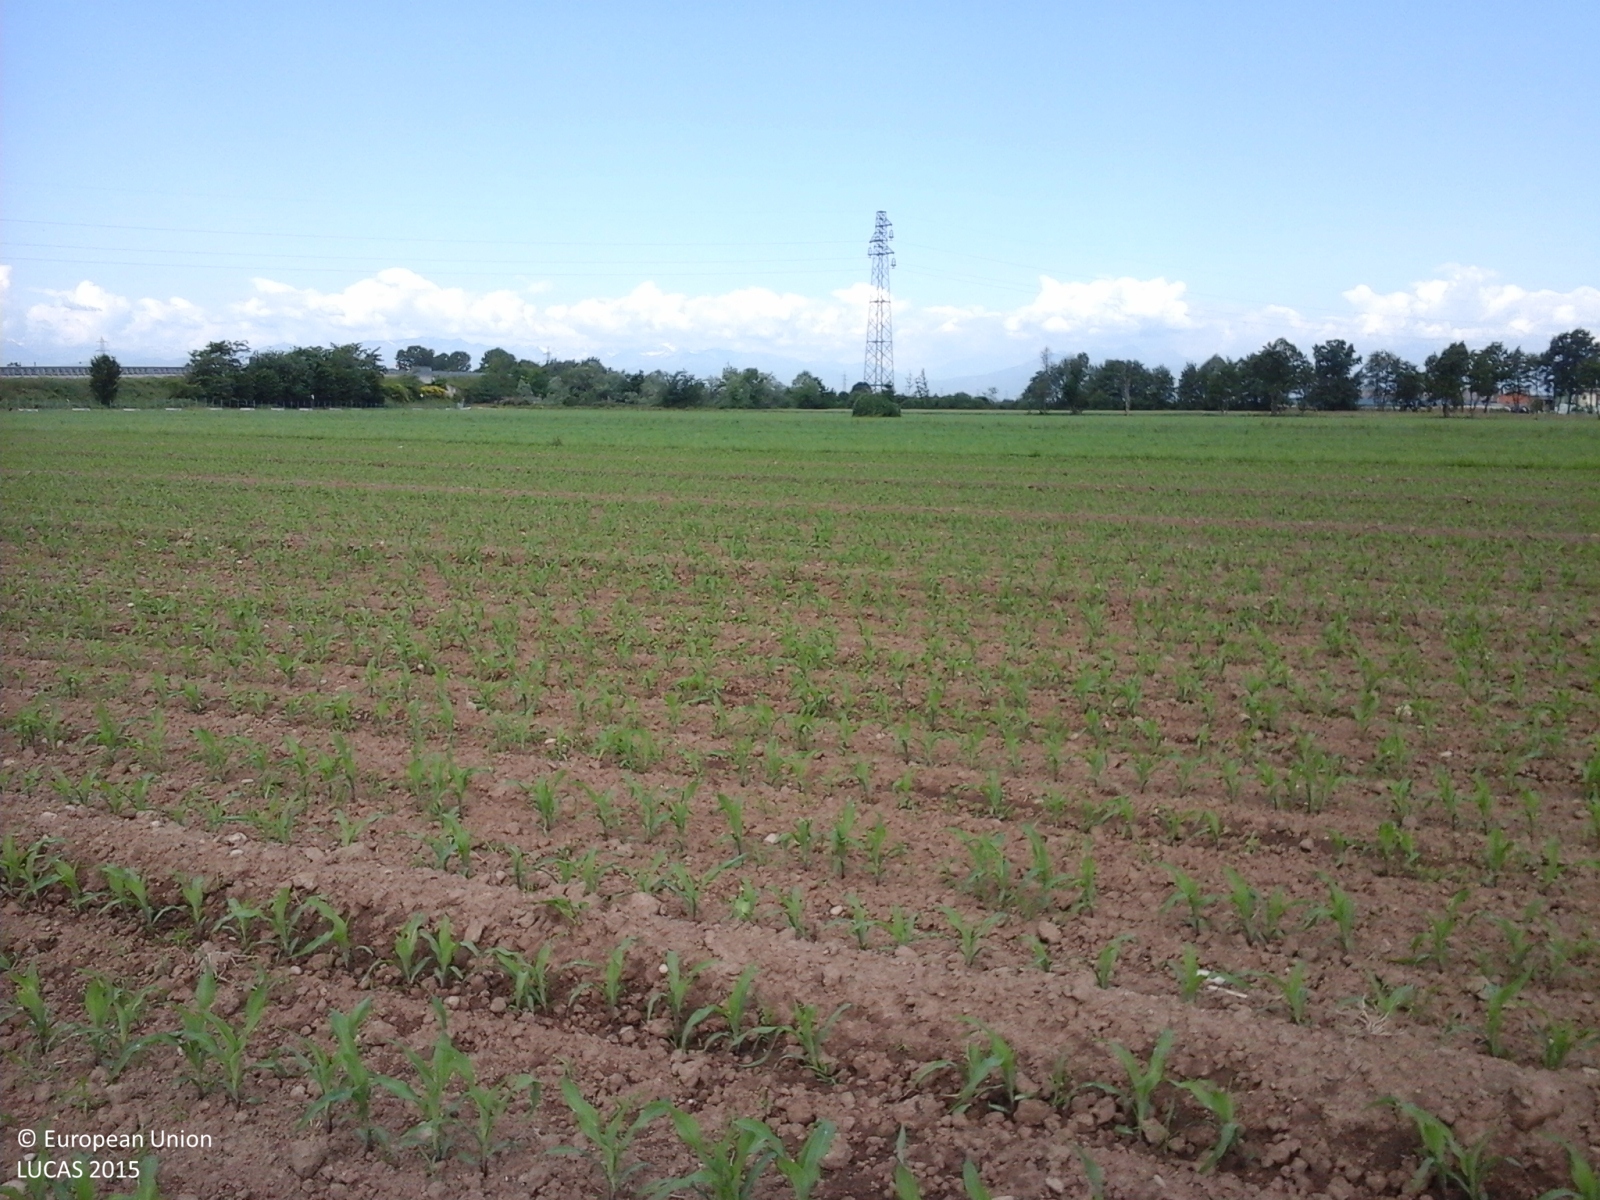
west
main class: Cropland
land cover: Maize
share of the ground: 10 - 25 %
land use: Agriculture (excluding fallow land and kitchen gardens)
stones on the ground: 10 - 25 %
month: May
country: IT
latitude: 44.4706
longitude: 7.7545
